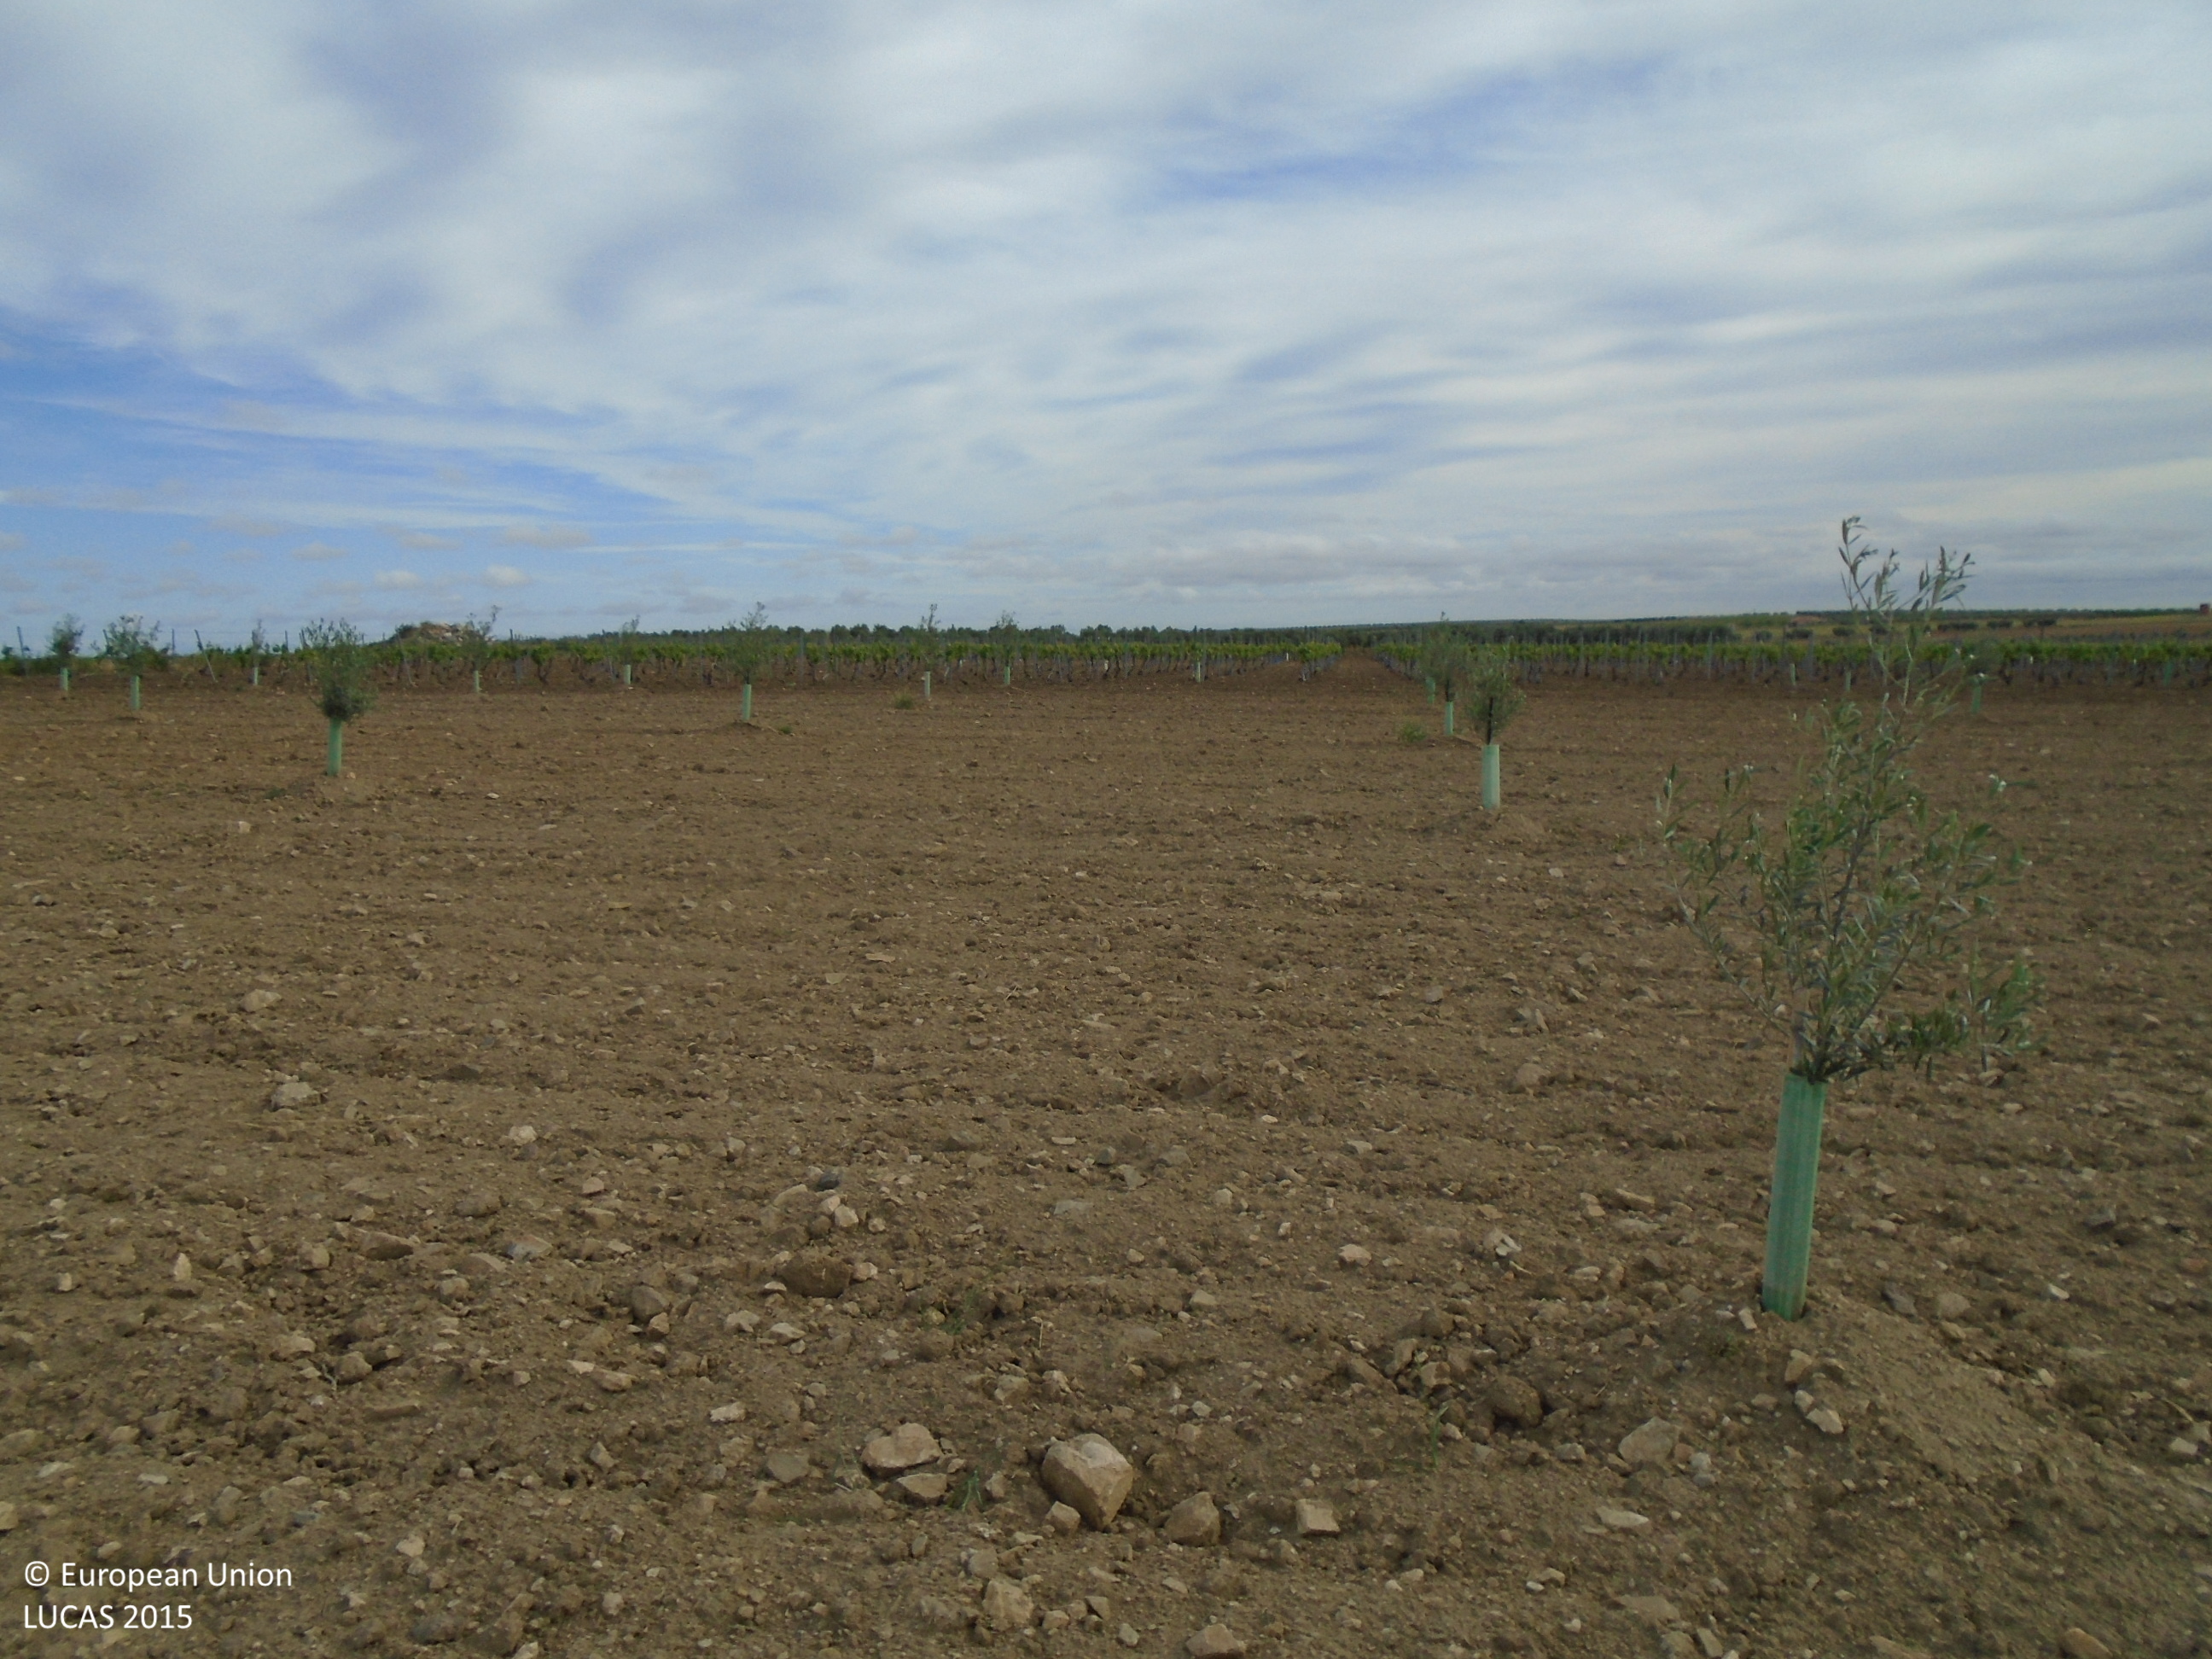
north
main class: Cropland
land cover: Olive groves
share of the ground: < 10 %
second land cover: Other bare soil
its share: > 75 %
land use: Agriculture (excluding fallow land and kitchen gardens)
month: May
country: ES
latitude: 39.7112
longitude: -3.7813
